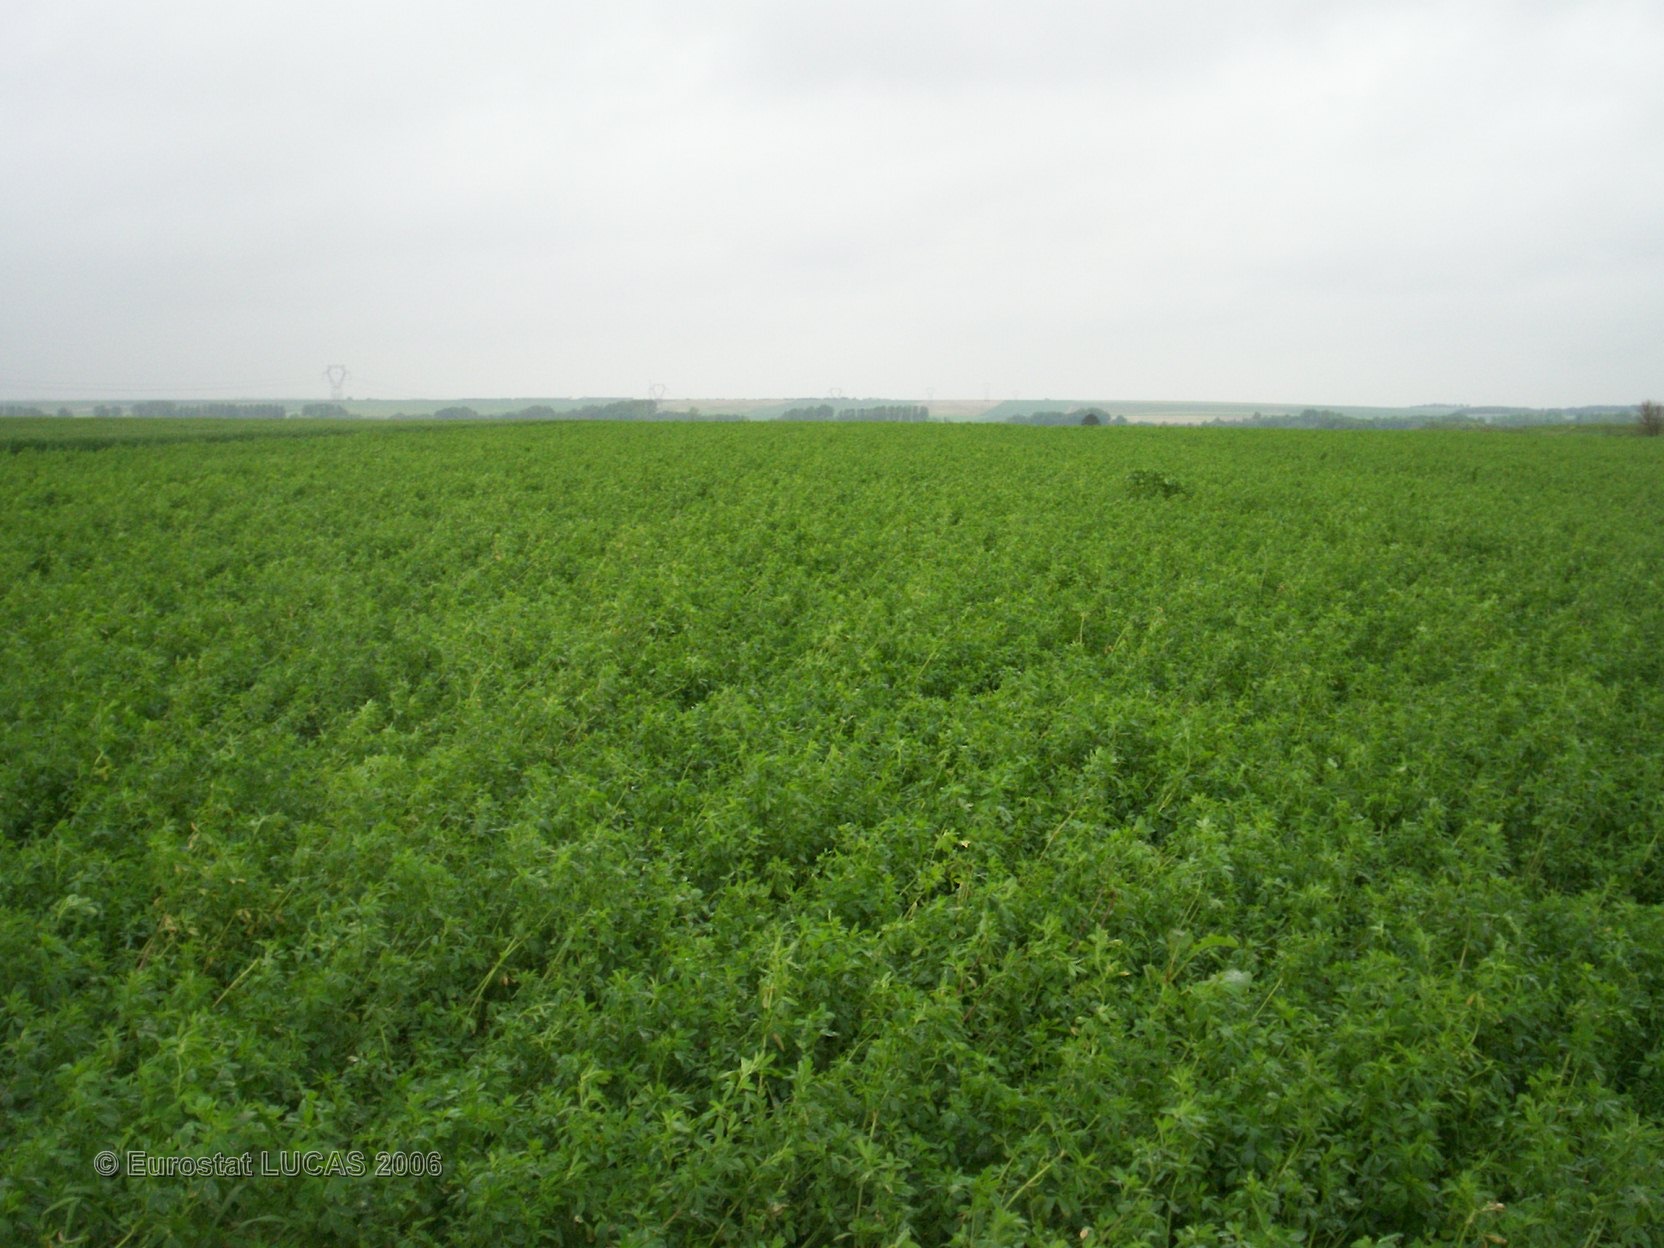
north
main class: Cropland
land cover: Lucerne
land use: Agriculture (excluding fallow land and kitchen gardens)
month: May
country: FR
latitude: 49.3805
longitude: 4.4175
